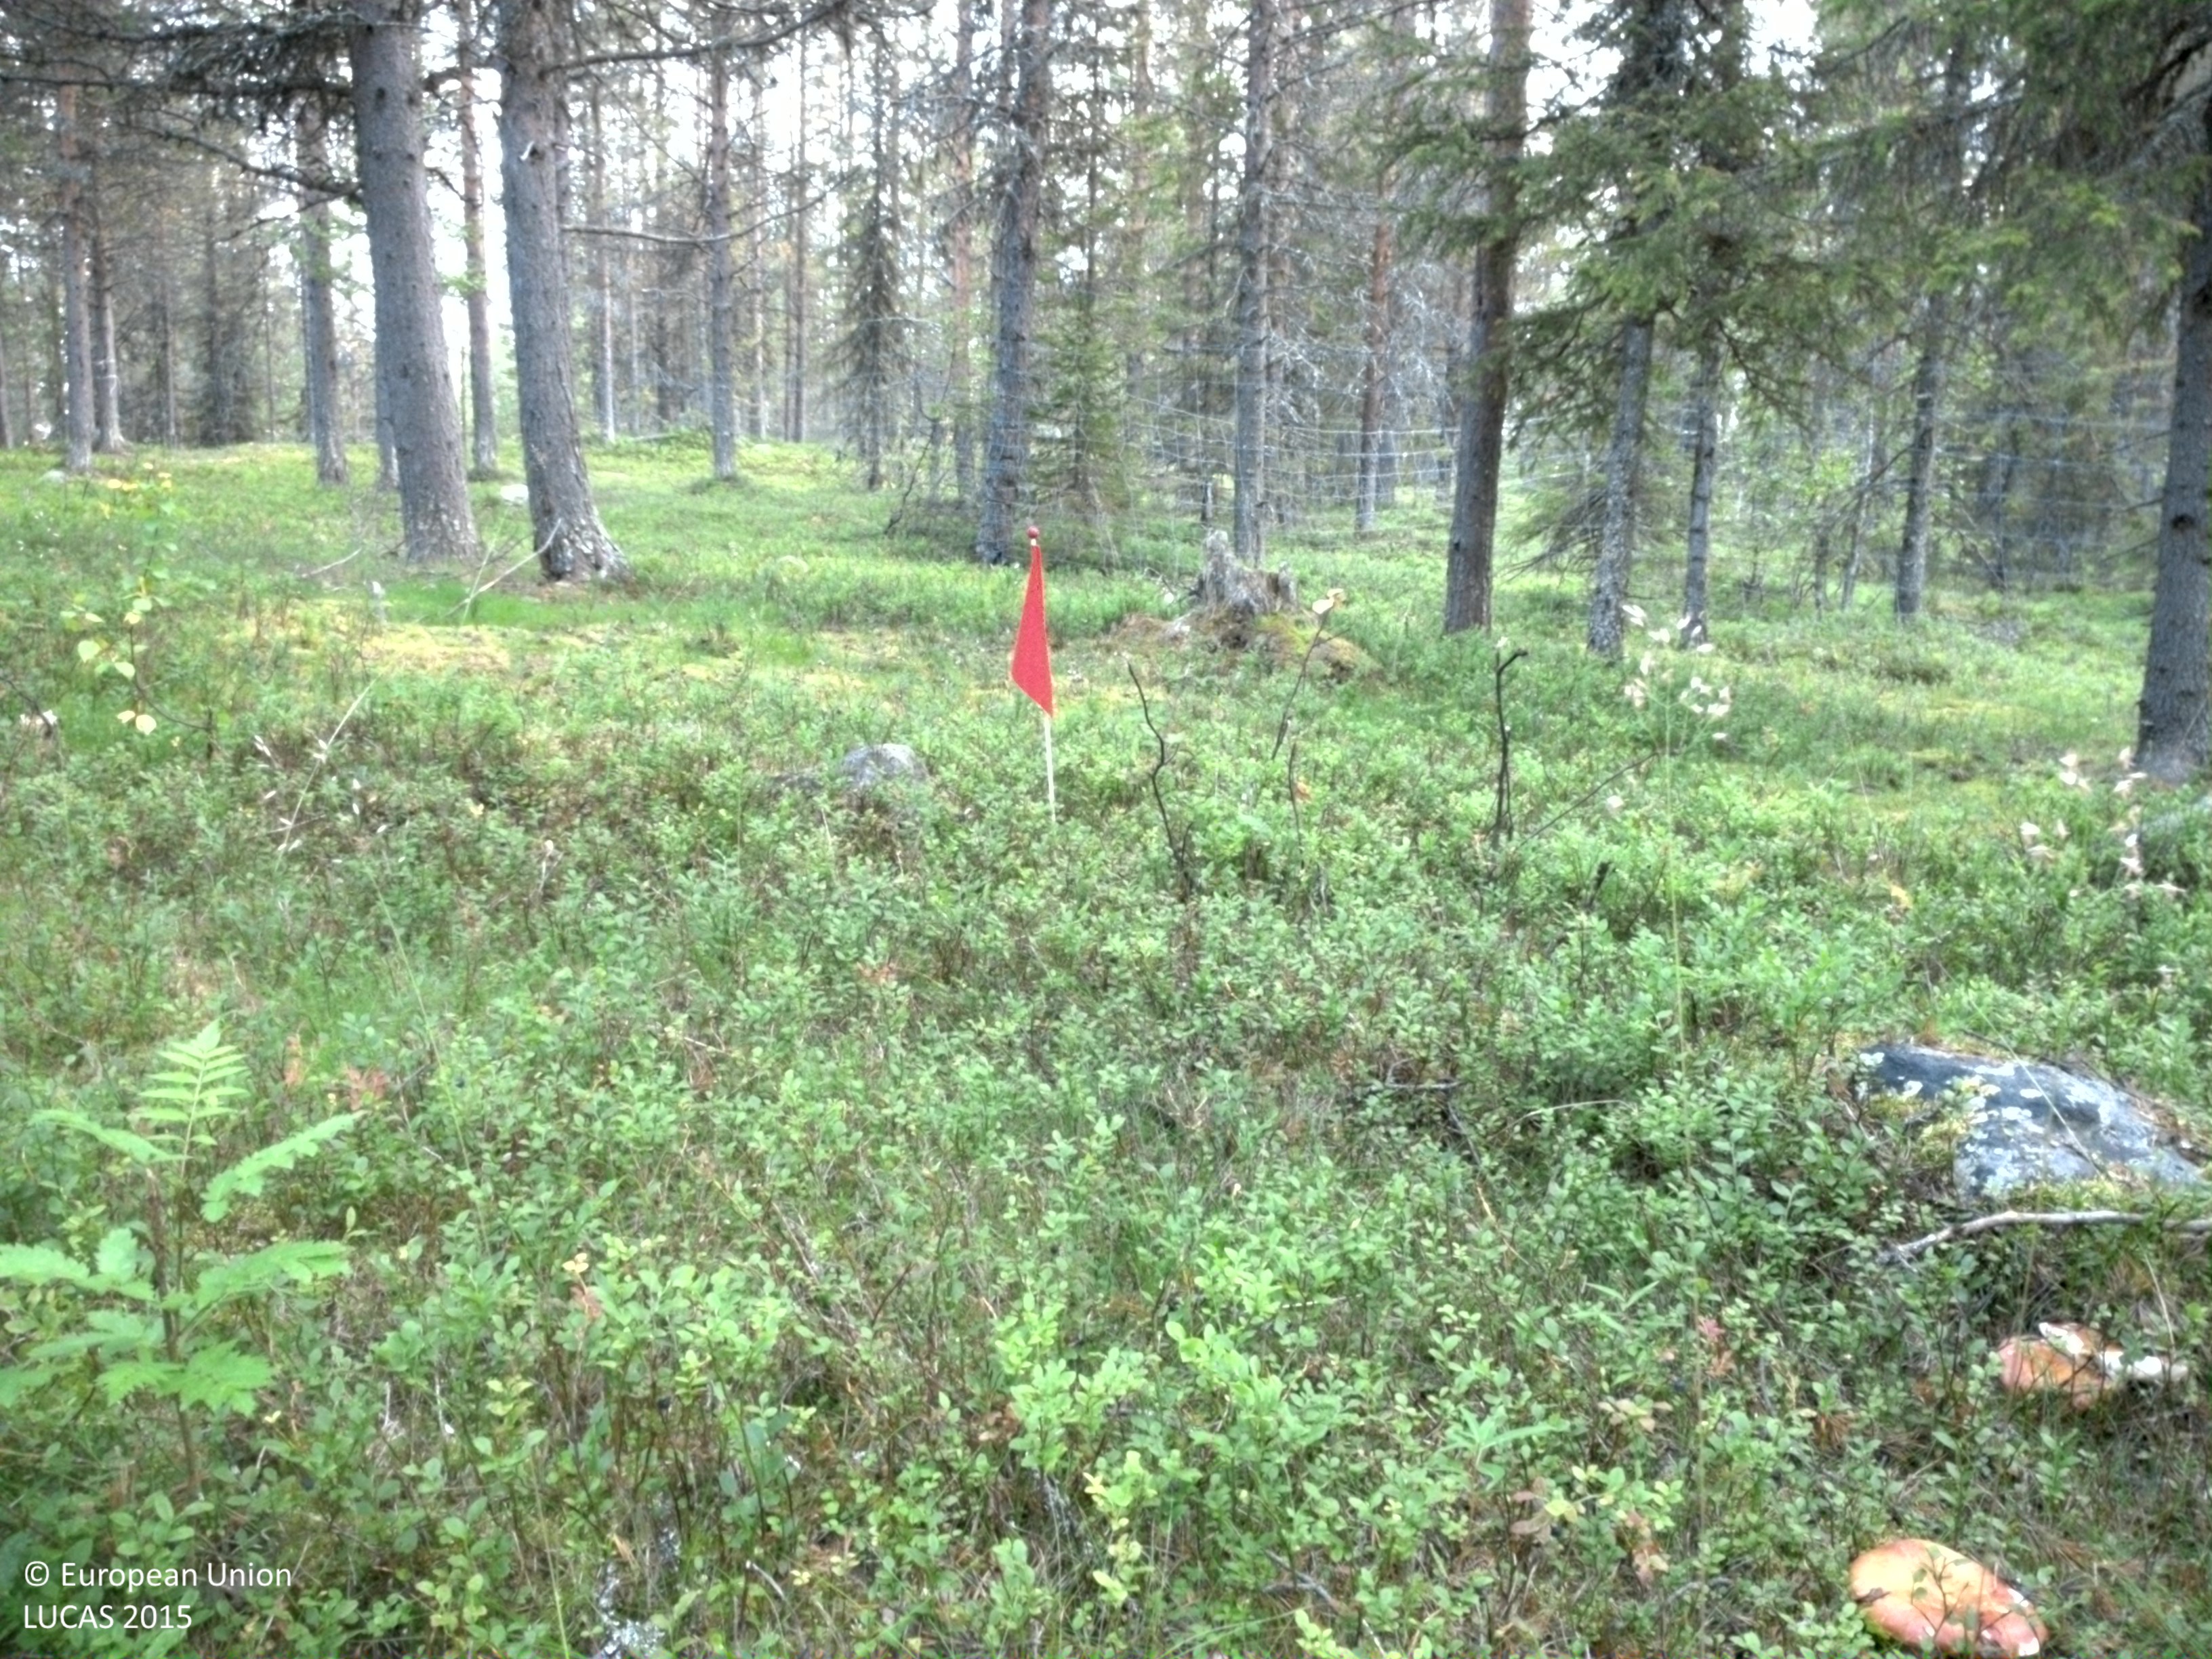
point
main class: Woodland
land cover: Pine dominated coniferous woodland
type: boreal forest
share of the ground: 25 - 50 %
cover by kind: shrubs 55 %, coniferous forest trees 30 %, broadleaved forest trees 5 %, herbaceous plants 5 %, lichens and mosses 5 %
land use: Forestry
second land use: Other primary production
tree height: > 5 m
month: August
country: SE
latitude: 66.6553
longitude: 20.6065
